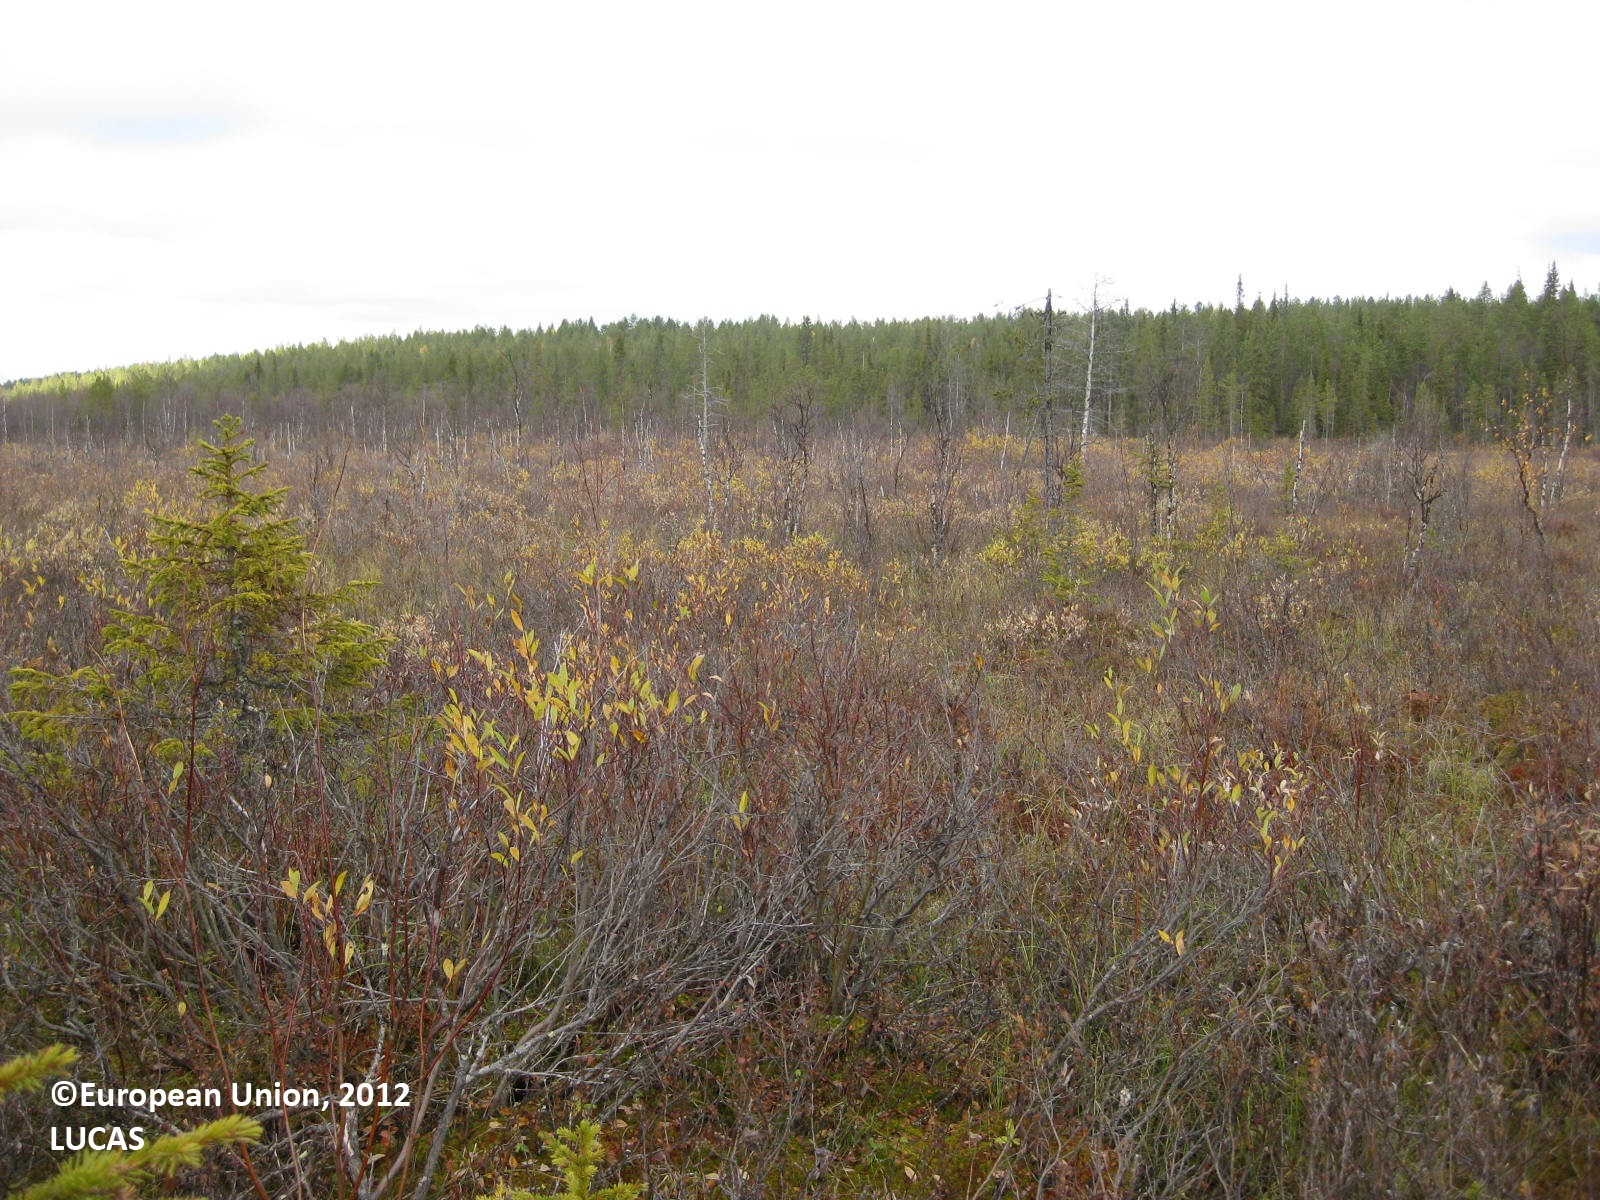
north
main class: Woodland
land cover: Pine dominated mixed woodland
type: boreal forest
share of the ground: 25 - 50 %
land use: Semi-natural and natural areas not in use
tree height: > 5 m
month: September
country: FI
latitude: 67.9908
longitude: 23.6163
